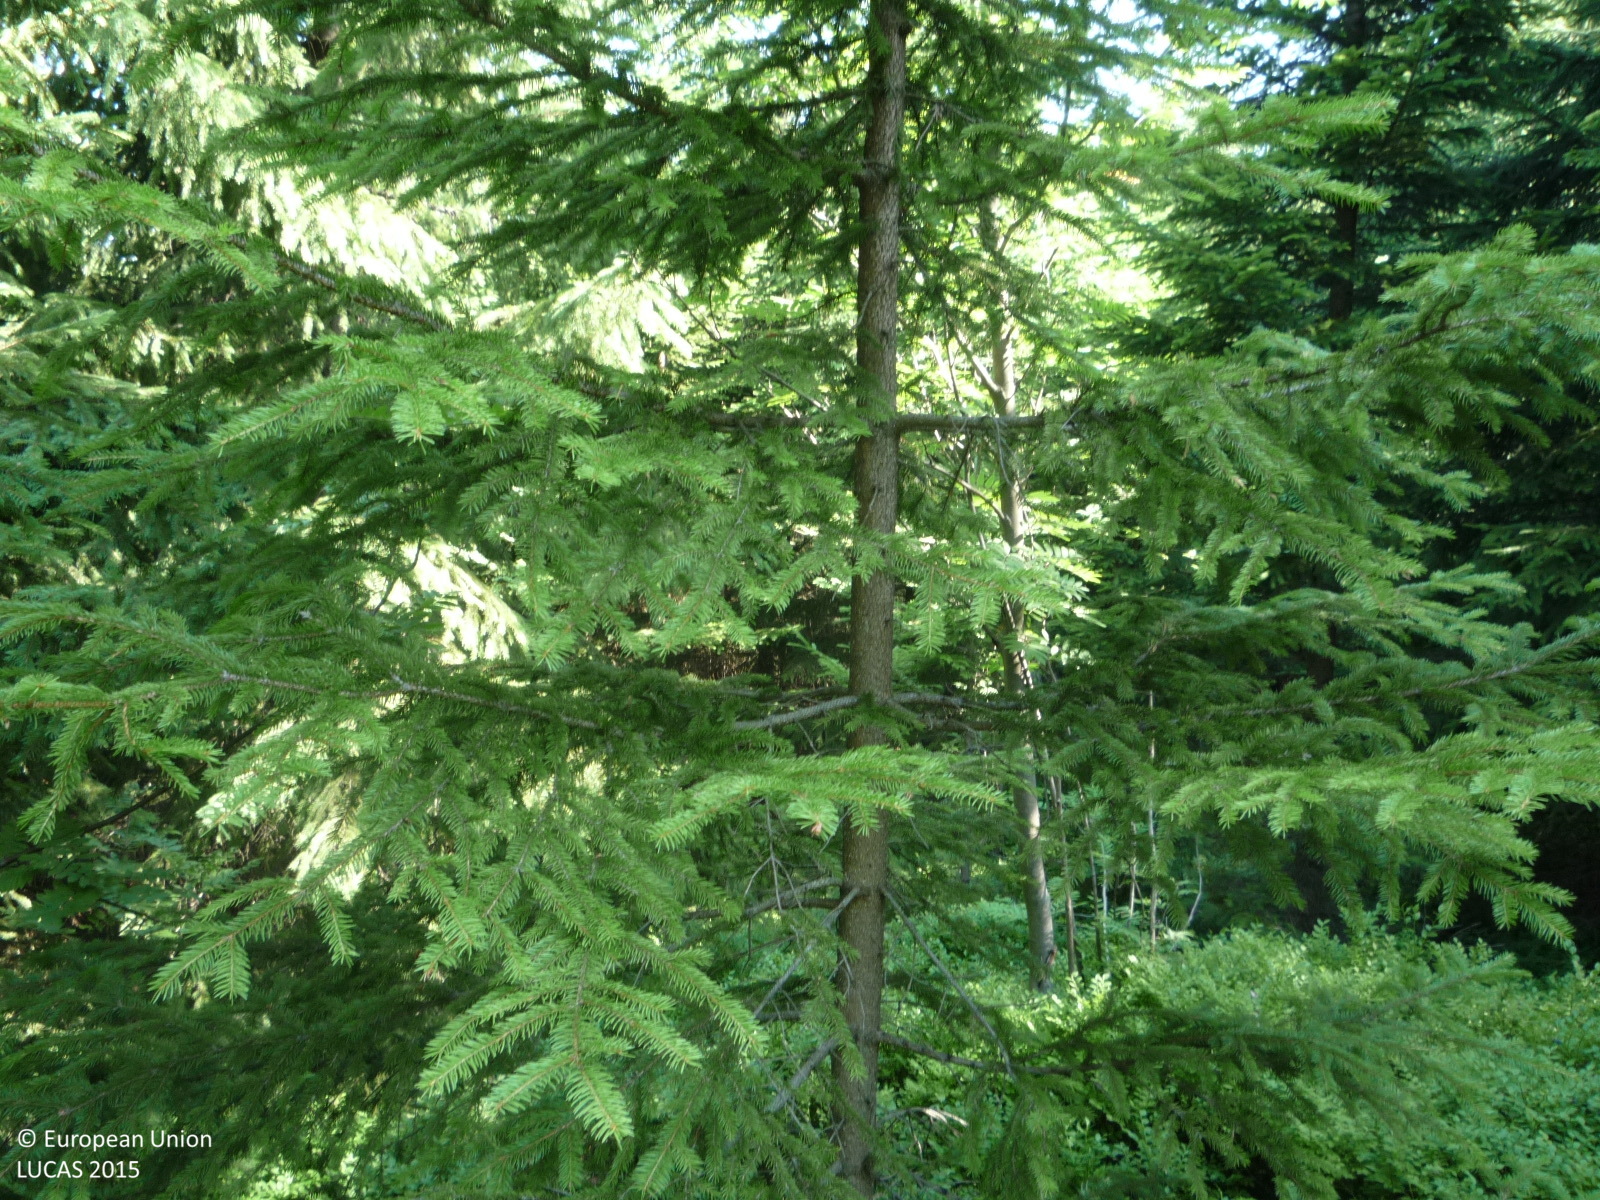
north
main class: Woodland
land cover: Spruce dominated coniferous woodland
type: hemiboreal forest and nemoral coniferous forest and mixed broadleaved-coniferous forest
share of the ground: > 75 %
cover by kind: coniferous forest trees 80 %, herbaceous plants 10 %, broadleaved forest trees 5 %, shrubs 5 %
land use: Forestry
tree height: > 5 m
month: August
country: CZ
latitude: 50.7130
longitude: 15.2293
